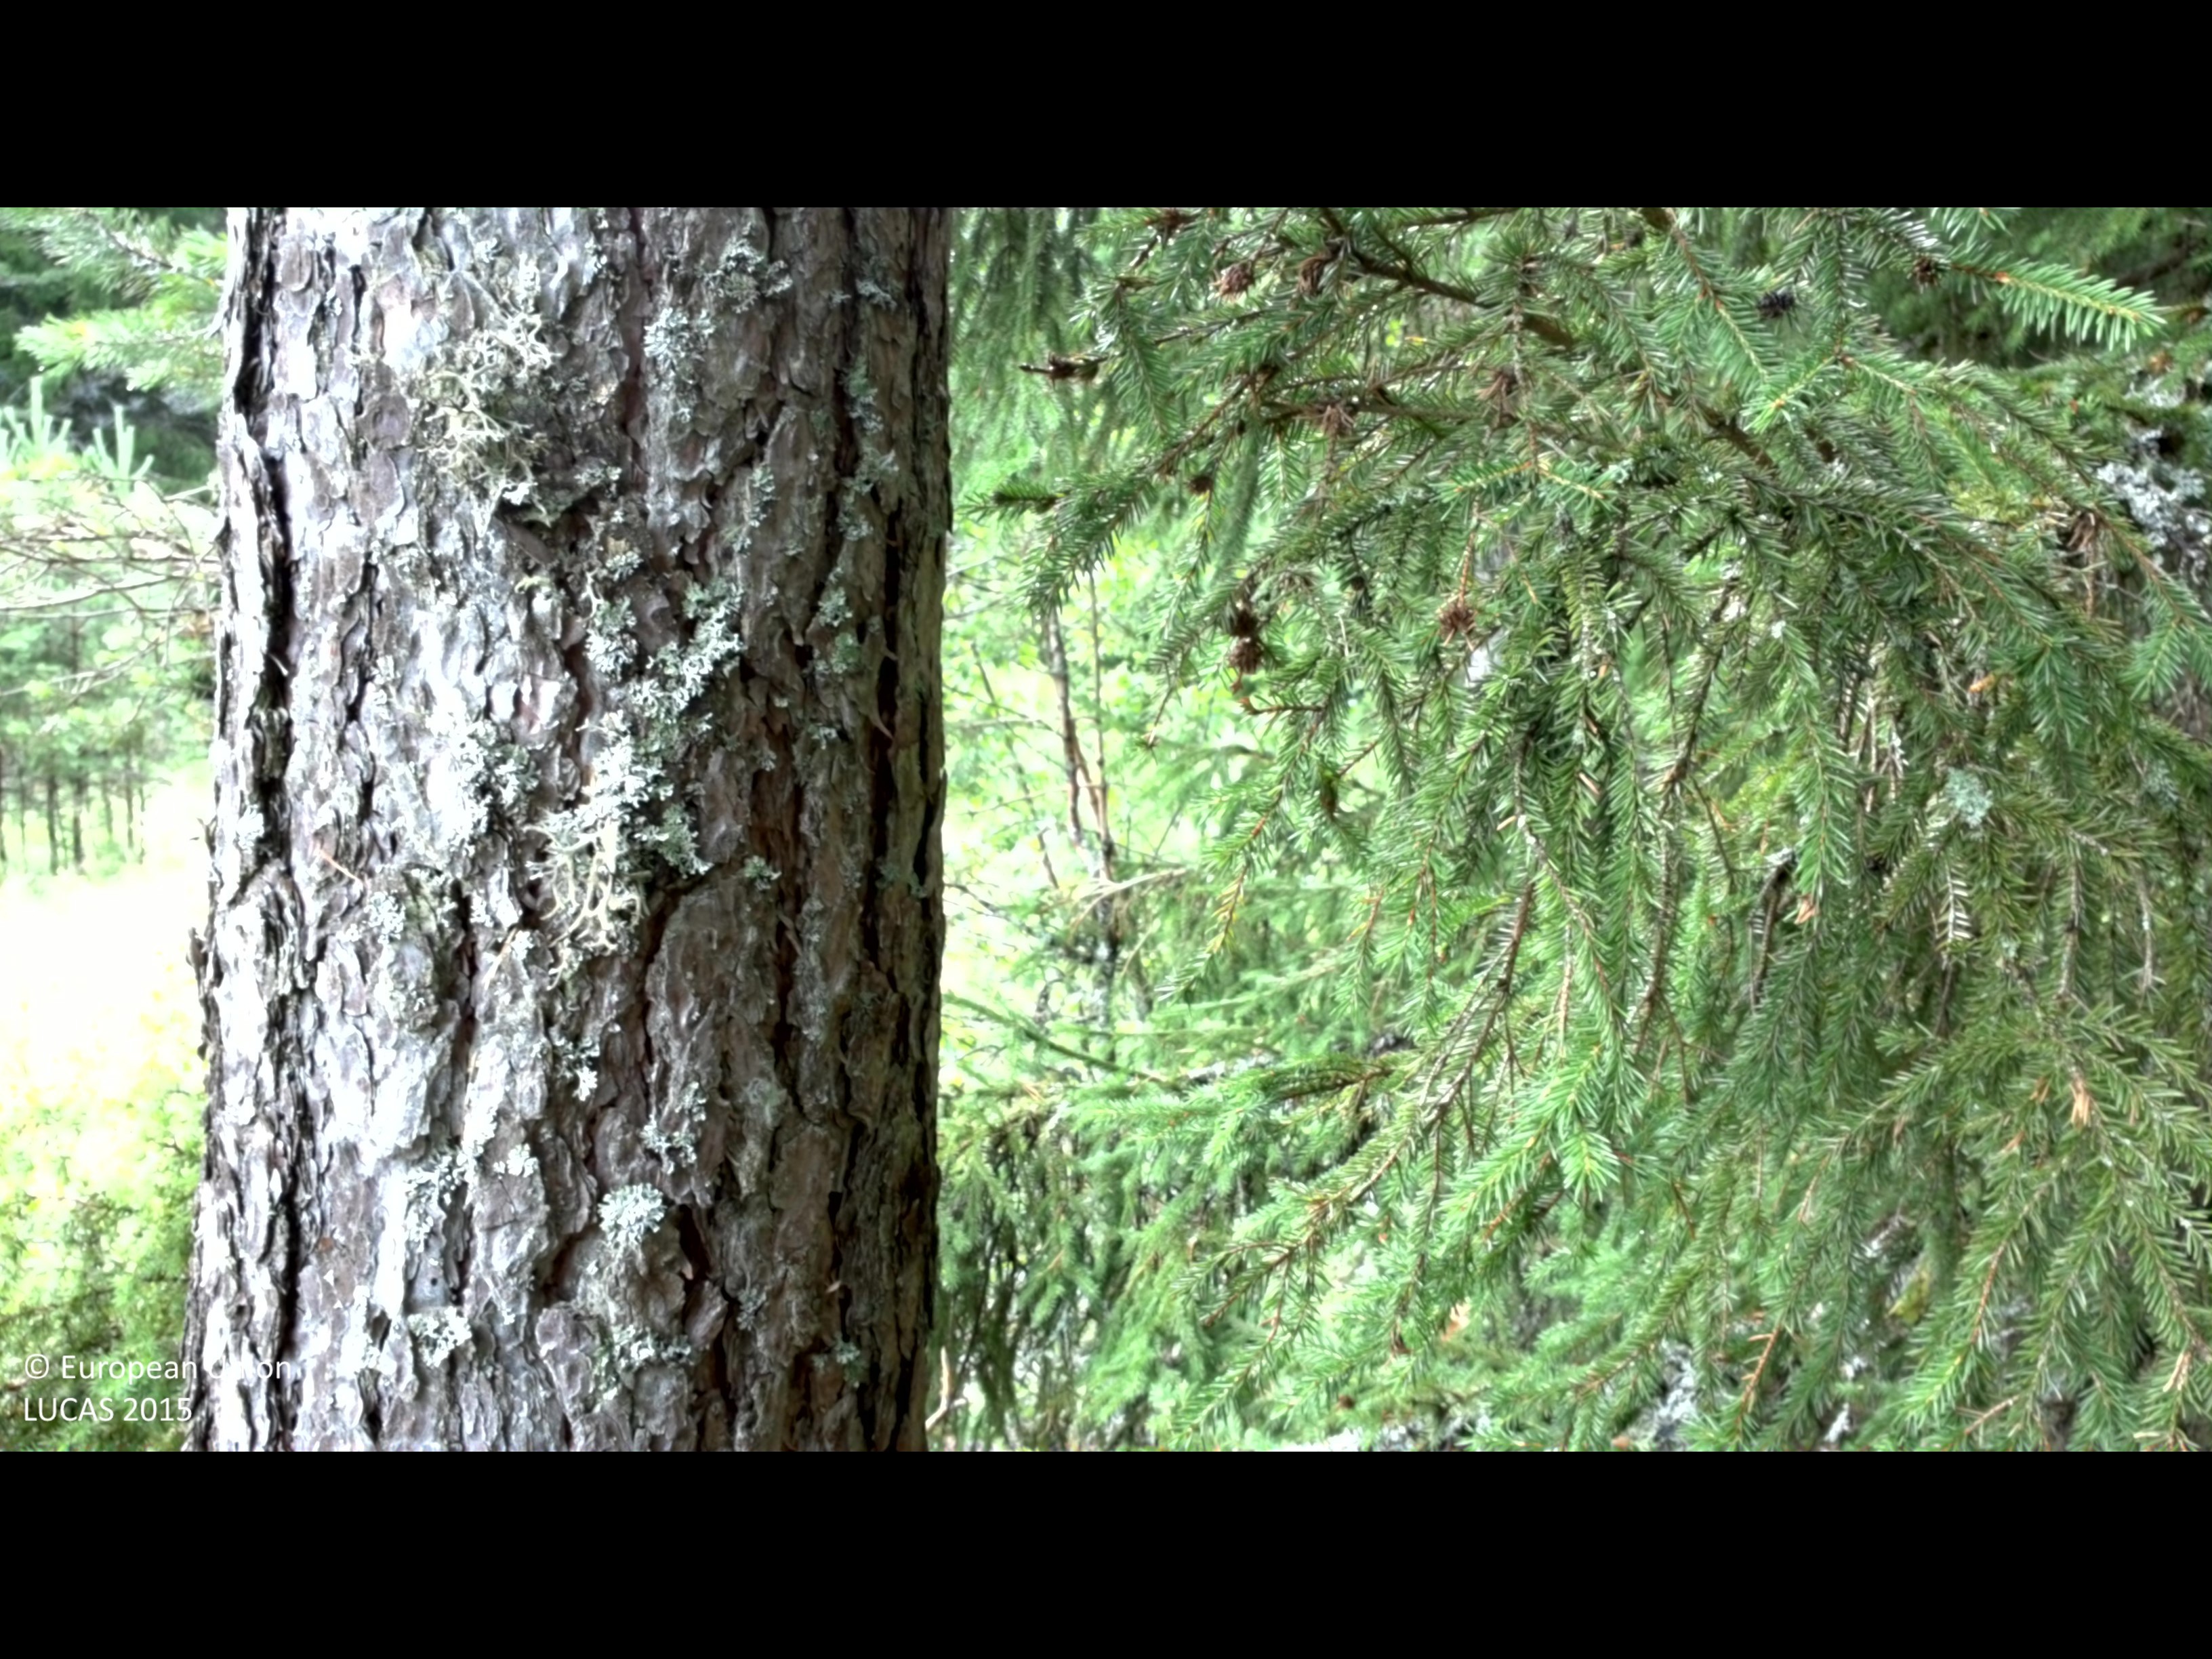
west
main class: Woodland
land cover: Pine dominated coniferous woodland
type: boreal forest
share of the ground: > 75 %
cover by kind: coniferous forest trees 80 %, shrubs 15 %, lichens and mosses 5 %
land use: Forestry
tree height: > 5 m
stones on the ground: 25 - 50 %
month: July
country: SE
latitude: 58.3621
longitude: 16.2688
